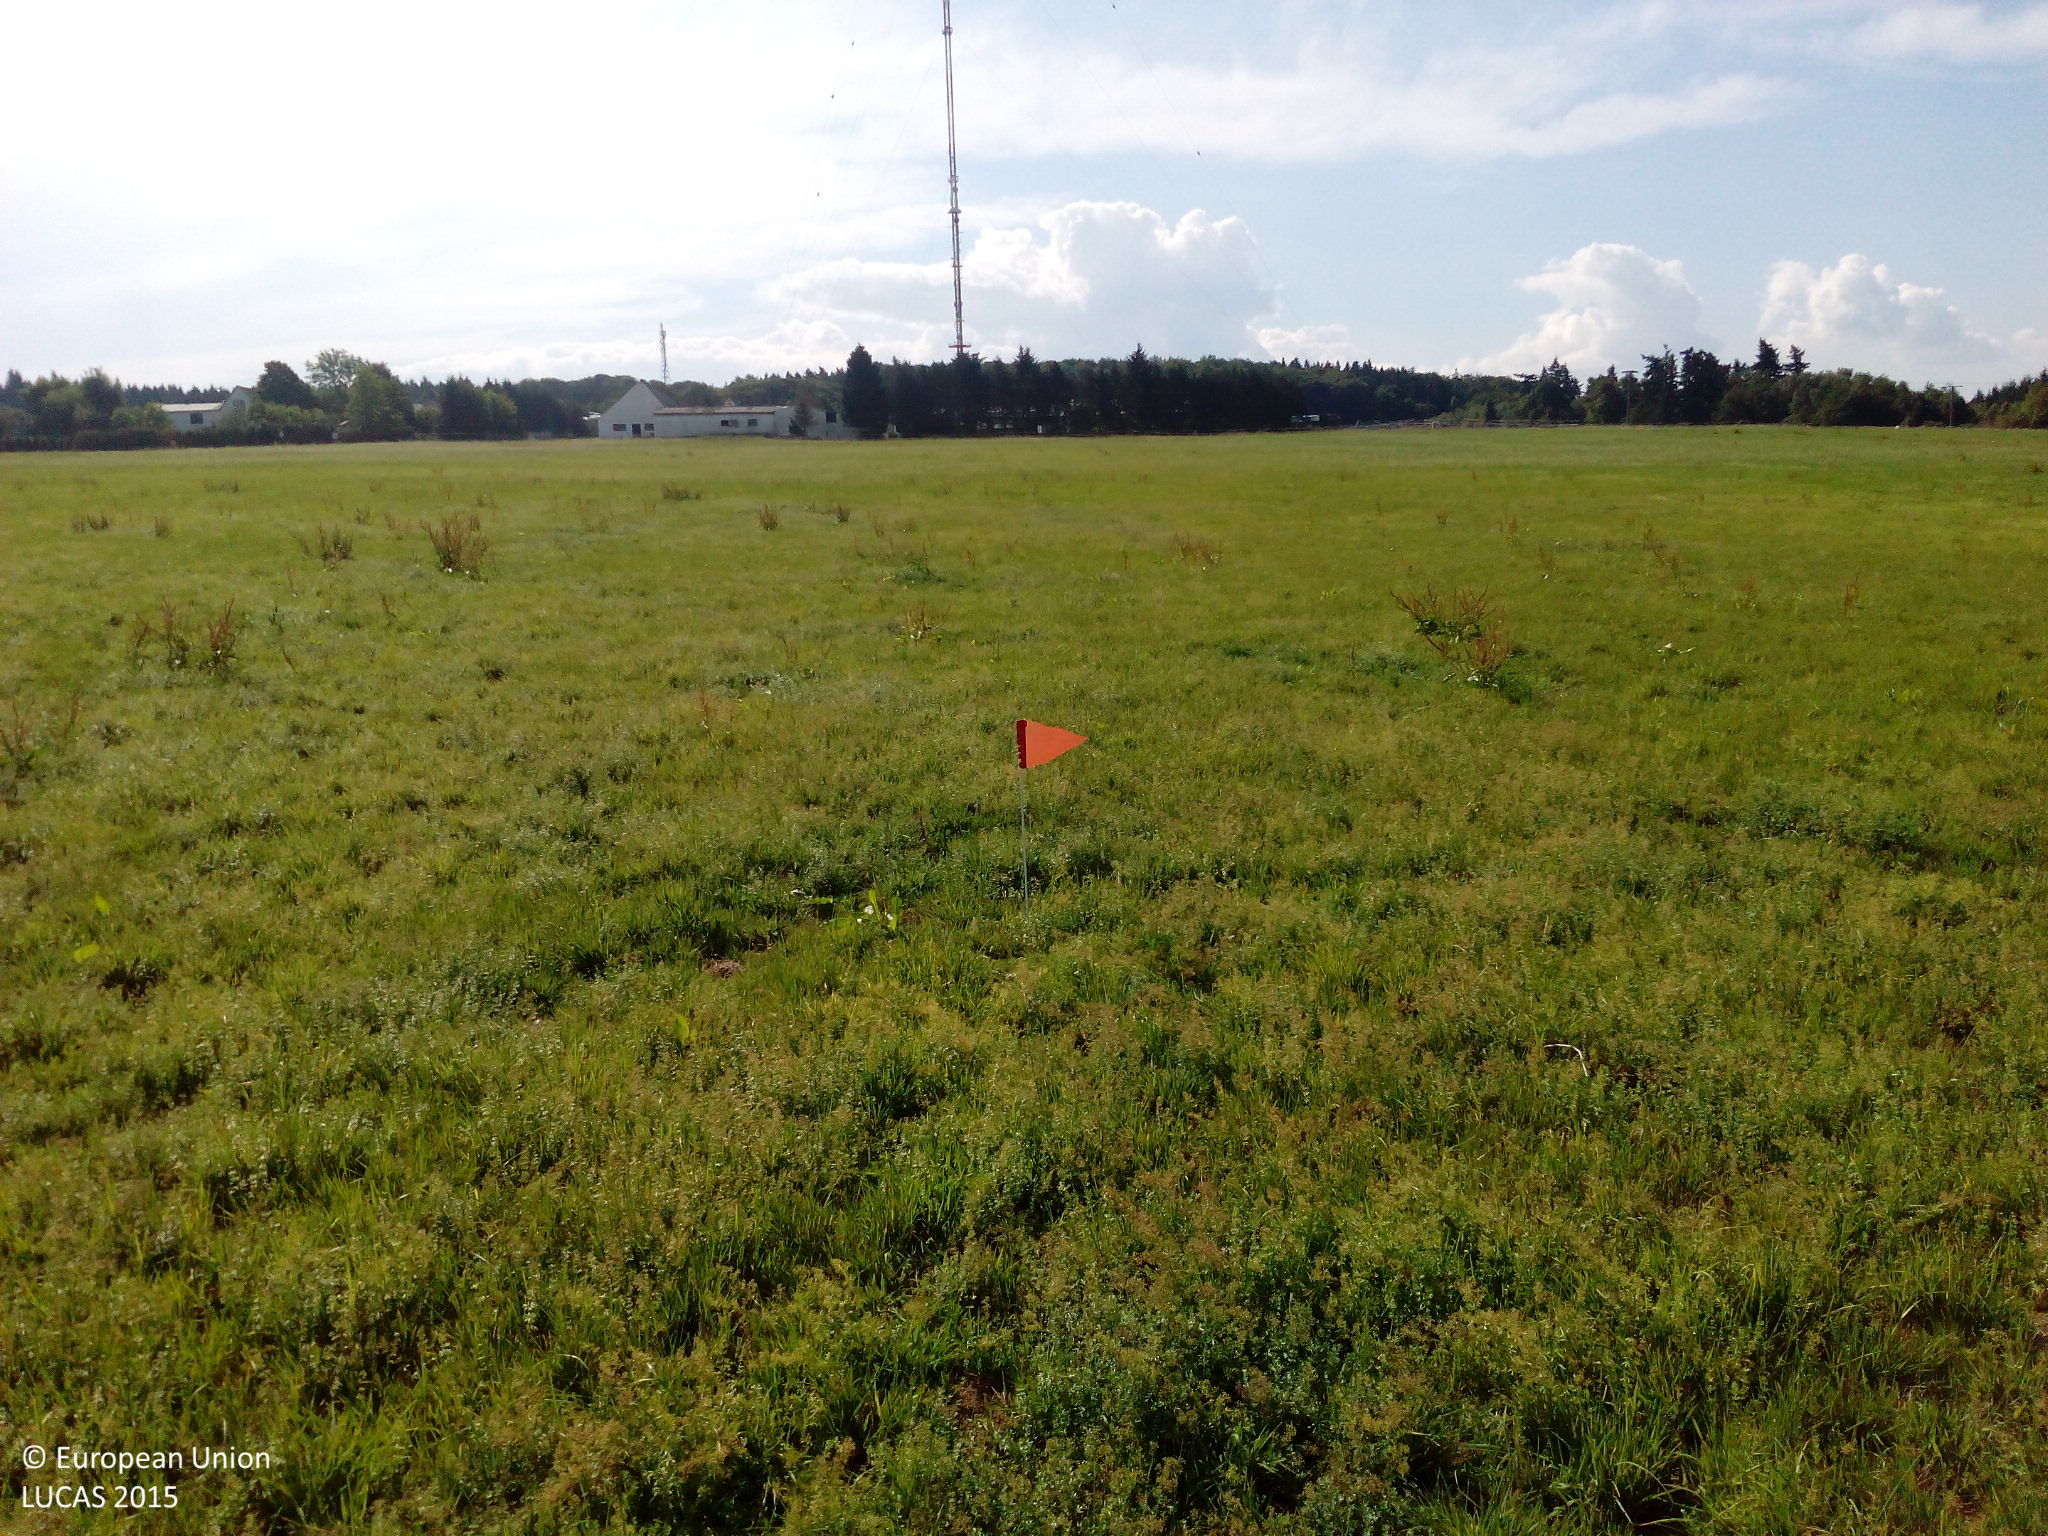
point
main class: Grassland
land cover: Grassland without tree/shrub cover
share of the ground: > 75 %
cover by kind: herbaceous plants 90 %, unconsolidated bare surface 10 %
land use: Agriculture (excluding fallow land and kitchen gardens)
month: August
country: DE
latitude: 50.2652
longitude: 7.5172
